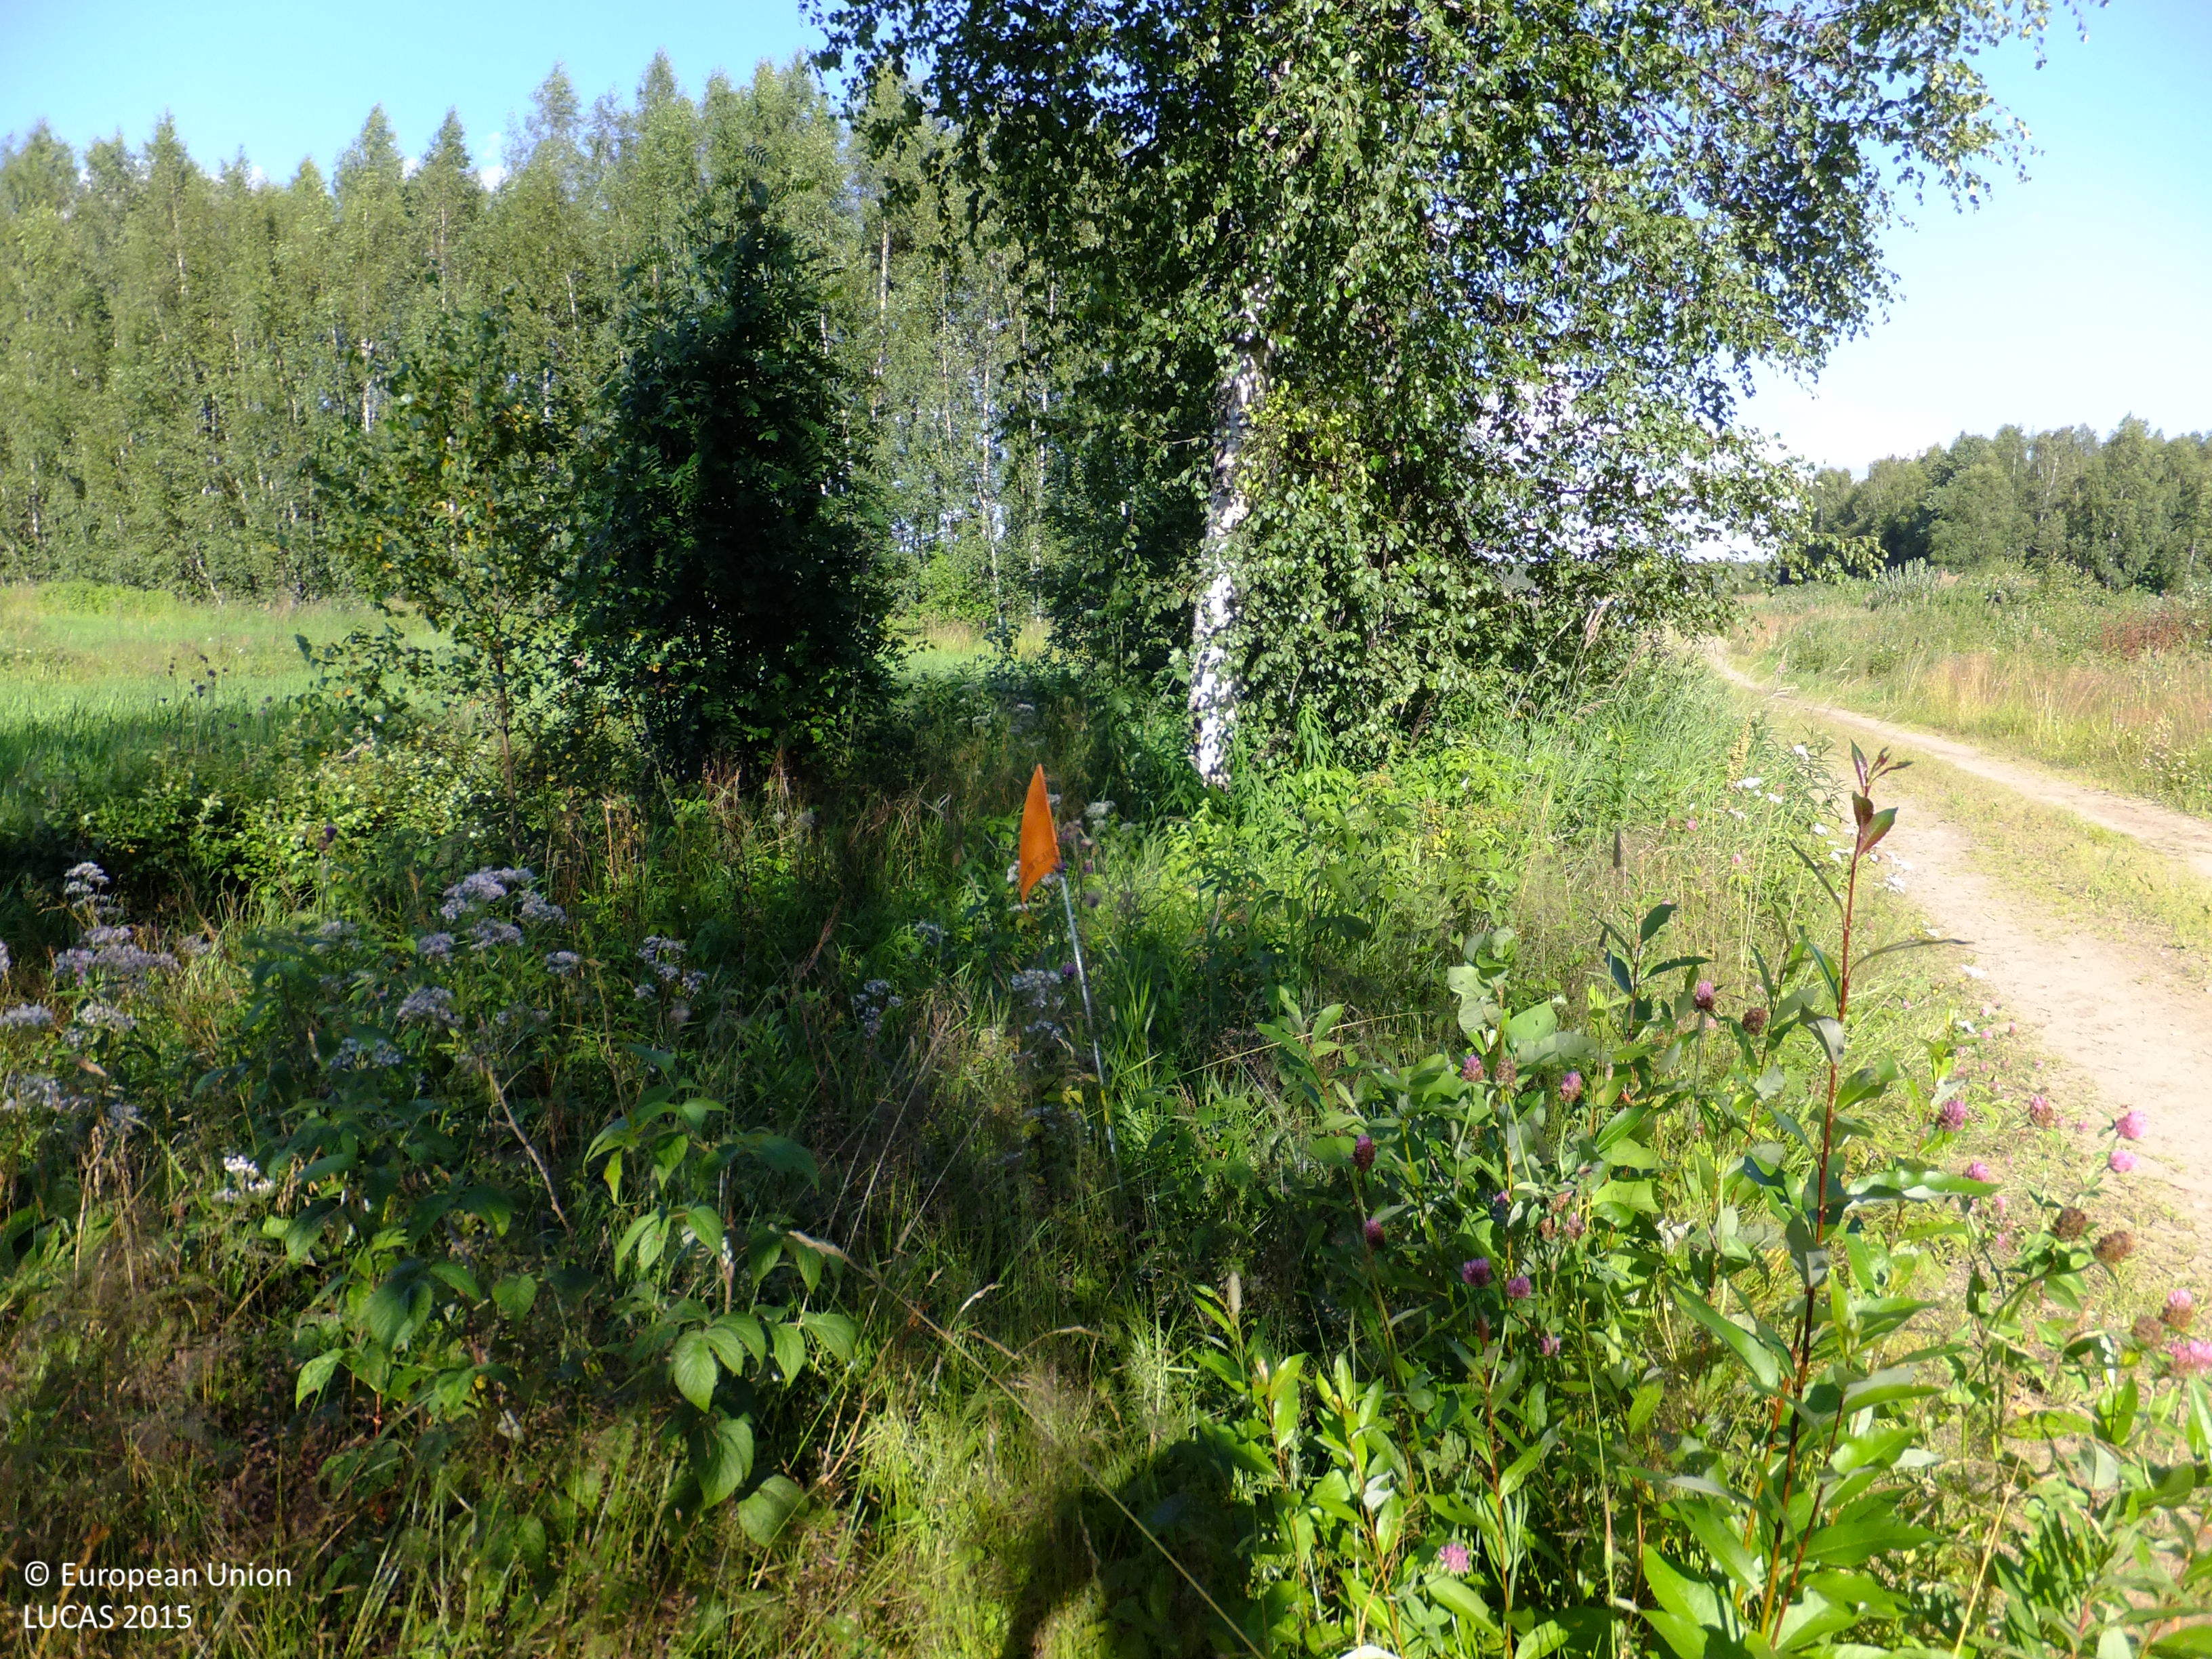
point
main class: Shrubland
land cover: Shrubland with sparse tree cover
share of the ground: > 75 %
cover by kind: shrubs 60 %, herbaceous plants 35 %, broadleaved forest trees 5 %
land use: Semi-natural and natural areas not in use
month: August
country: FI
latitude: 63.1335
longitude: 22.4863
